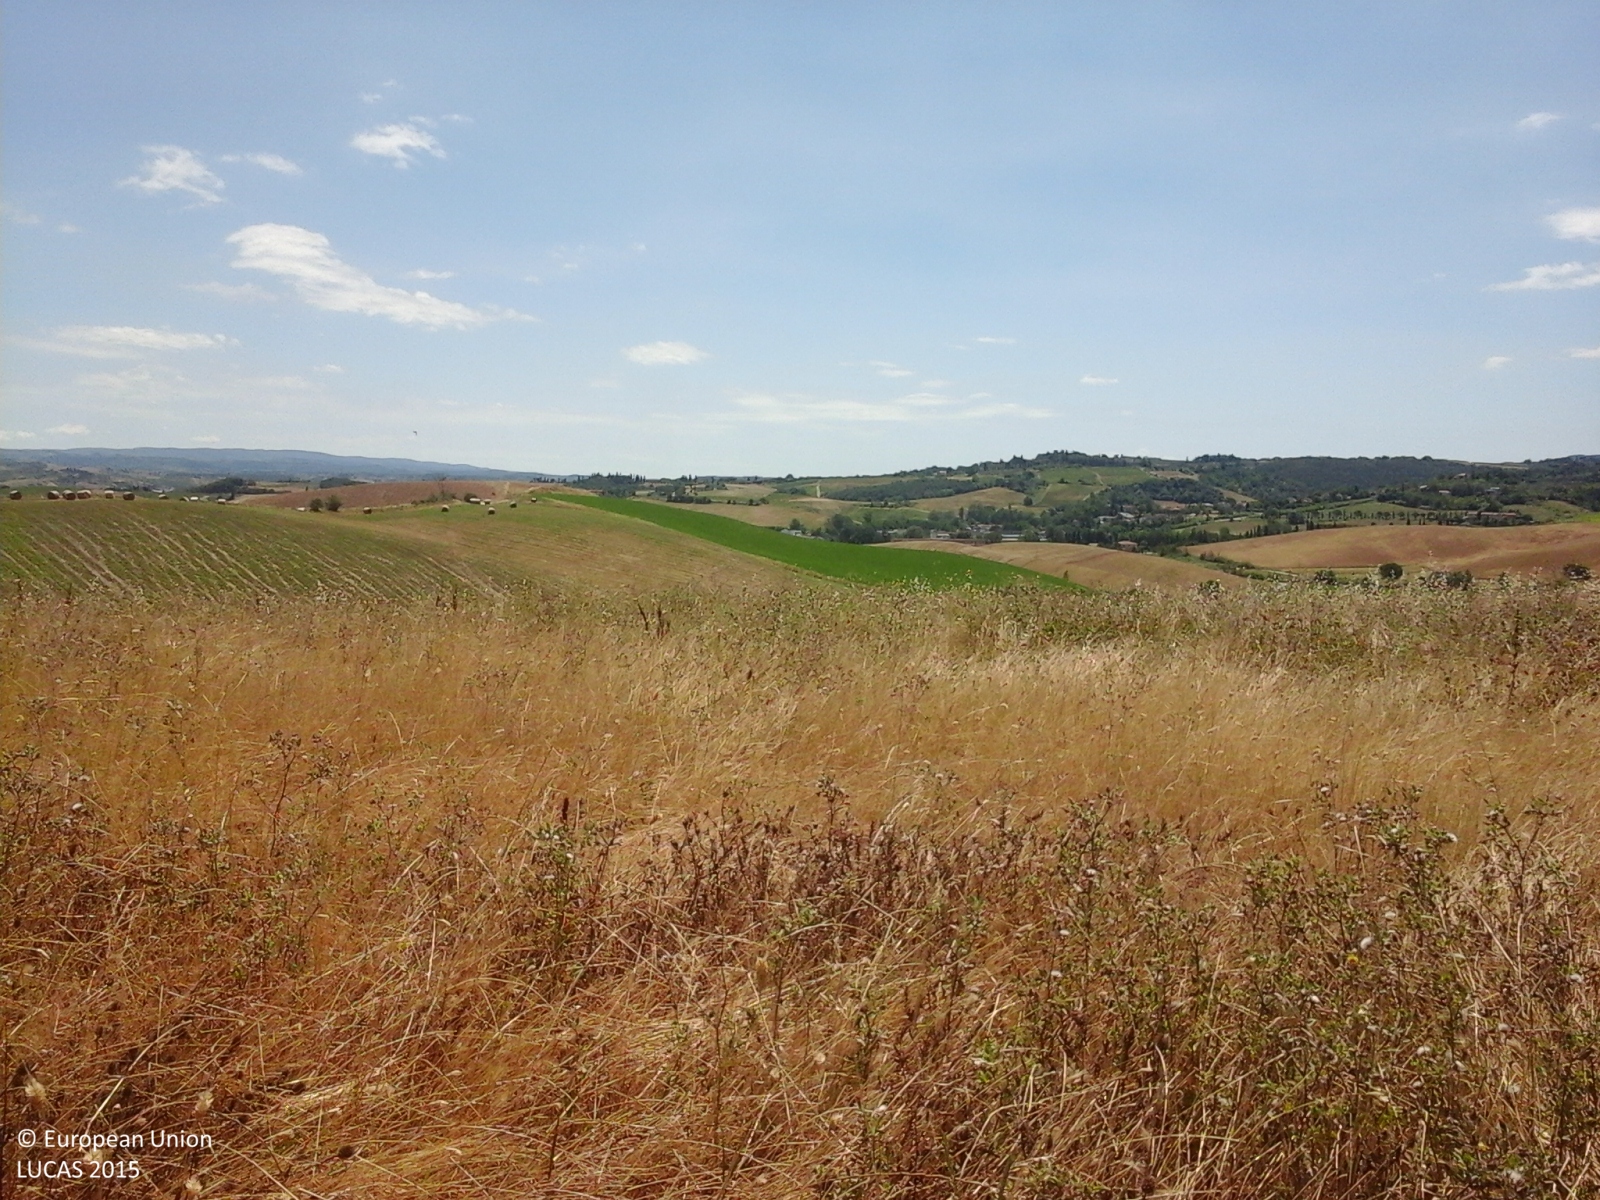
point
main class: Grassland
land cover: Grassland without tree/shrub cover
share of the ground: > 75 %
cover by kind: herbaceous plants 95 %, shrubs 5 %
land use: Agriculture (excluding fallow land and kitchen gardens)
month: June
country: IT
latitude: 43.5884
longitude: 10.9511
